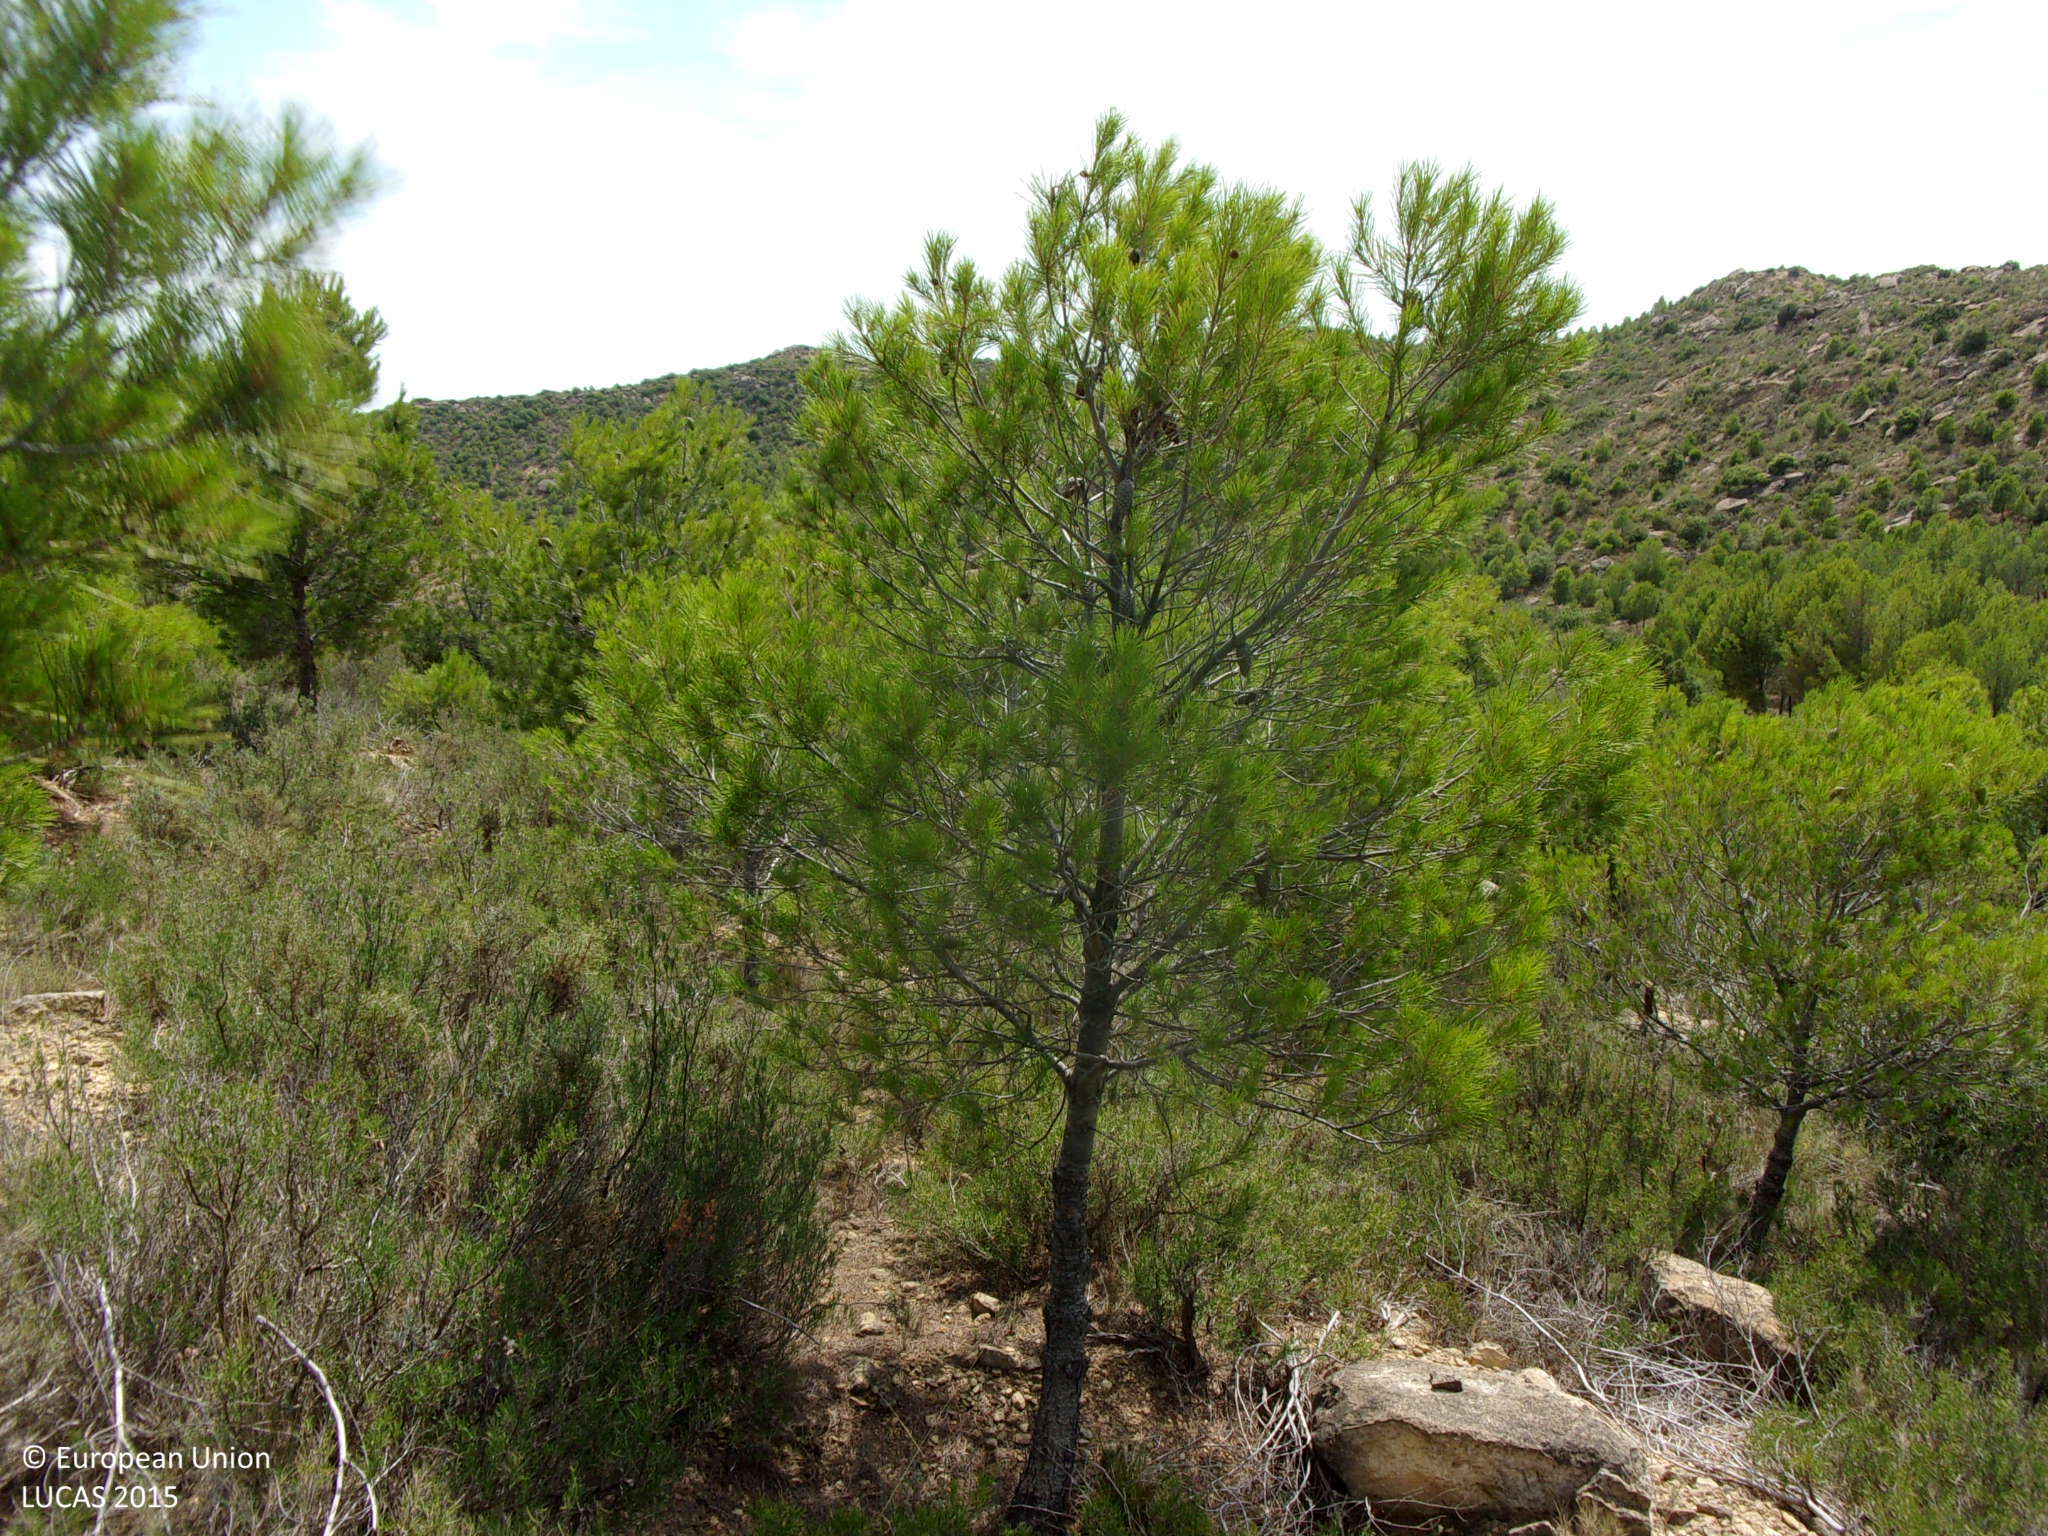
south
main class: Woodland
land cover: Pine dominated coniferous woodland
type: coniferous forest of the mediterranean region
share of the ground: 10 - 25 %
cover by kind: shrubs 50 %, coniferous forest trees 35 %, consolidated bare surface 15 %
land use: Forestry
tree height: < 5 m
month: August
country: ES
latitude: 42.1895
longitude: -1.0836
